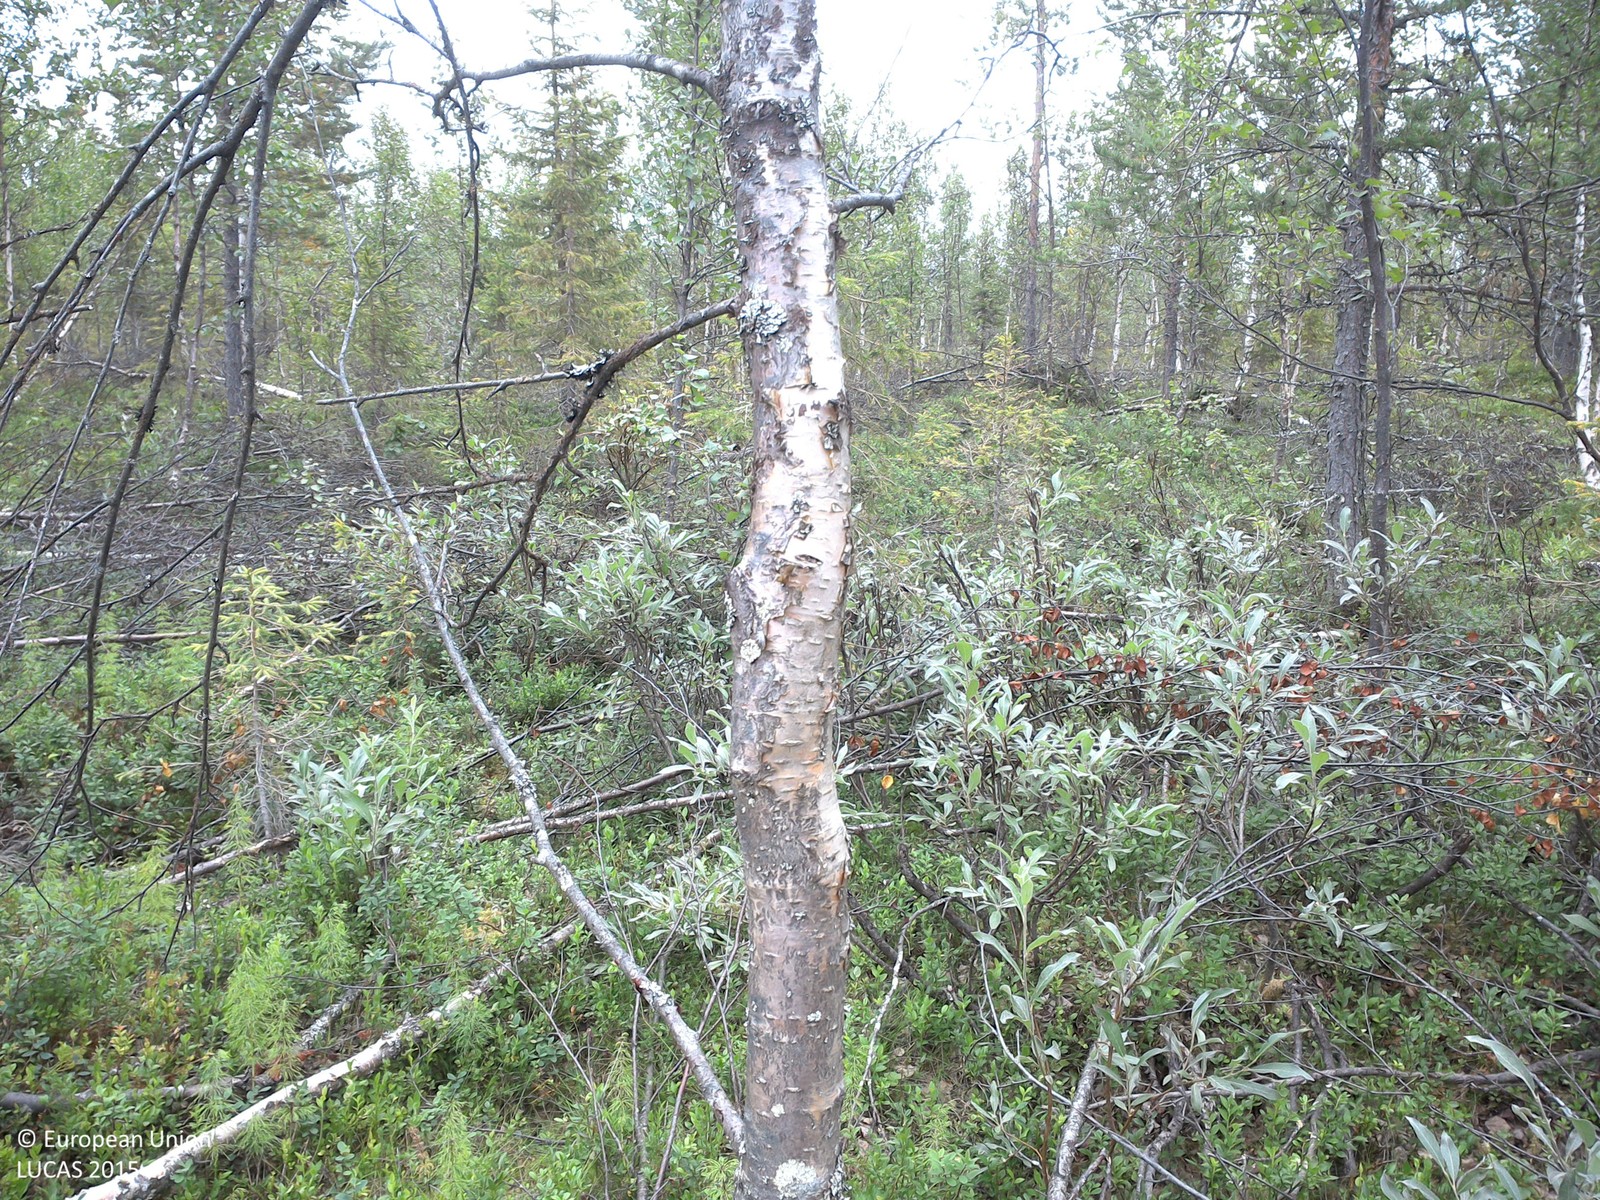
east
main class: Woodland
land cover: Pine dominated mixed woodland
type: boreal forest
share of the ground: 10 - 25 %
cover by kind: shrubs 80 %, coniferous forest trees 15 %, broadleaved forest trees 5 %
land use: Forestry
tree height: > 5 m
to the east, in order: Pine dominated mixed woodland; Broadleaved woodland; Pine dominated mixed woodland; Grass margins; Paved roads, cycling and walking lanes; Grass margins; Ditches and canals; Pine dominated mixed woodland
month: August
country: SE
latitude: 67.4487
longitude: 21.9403
